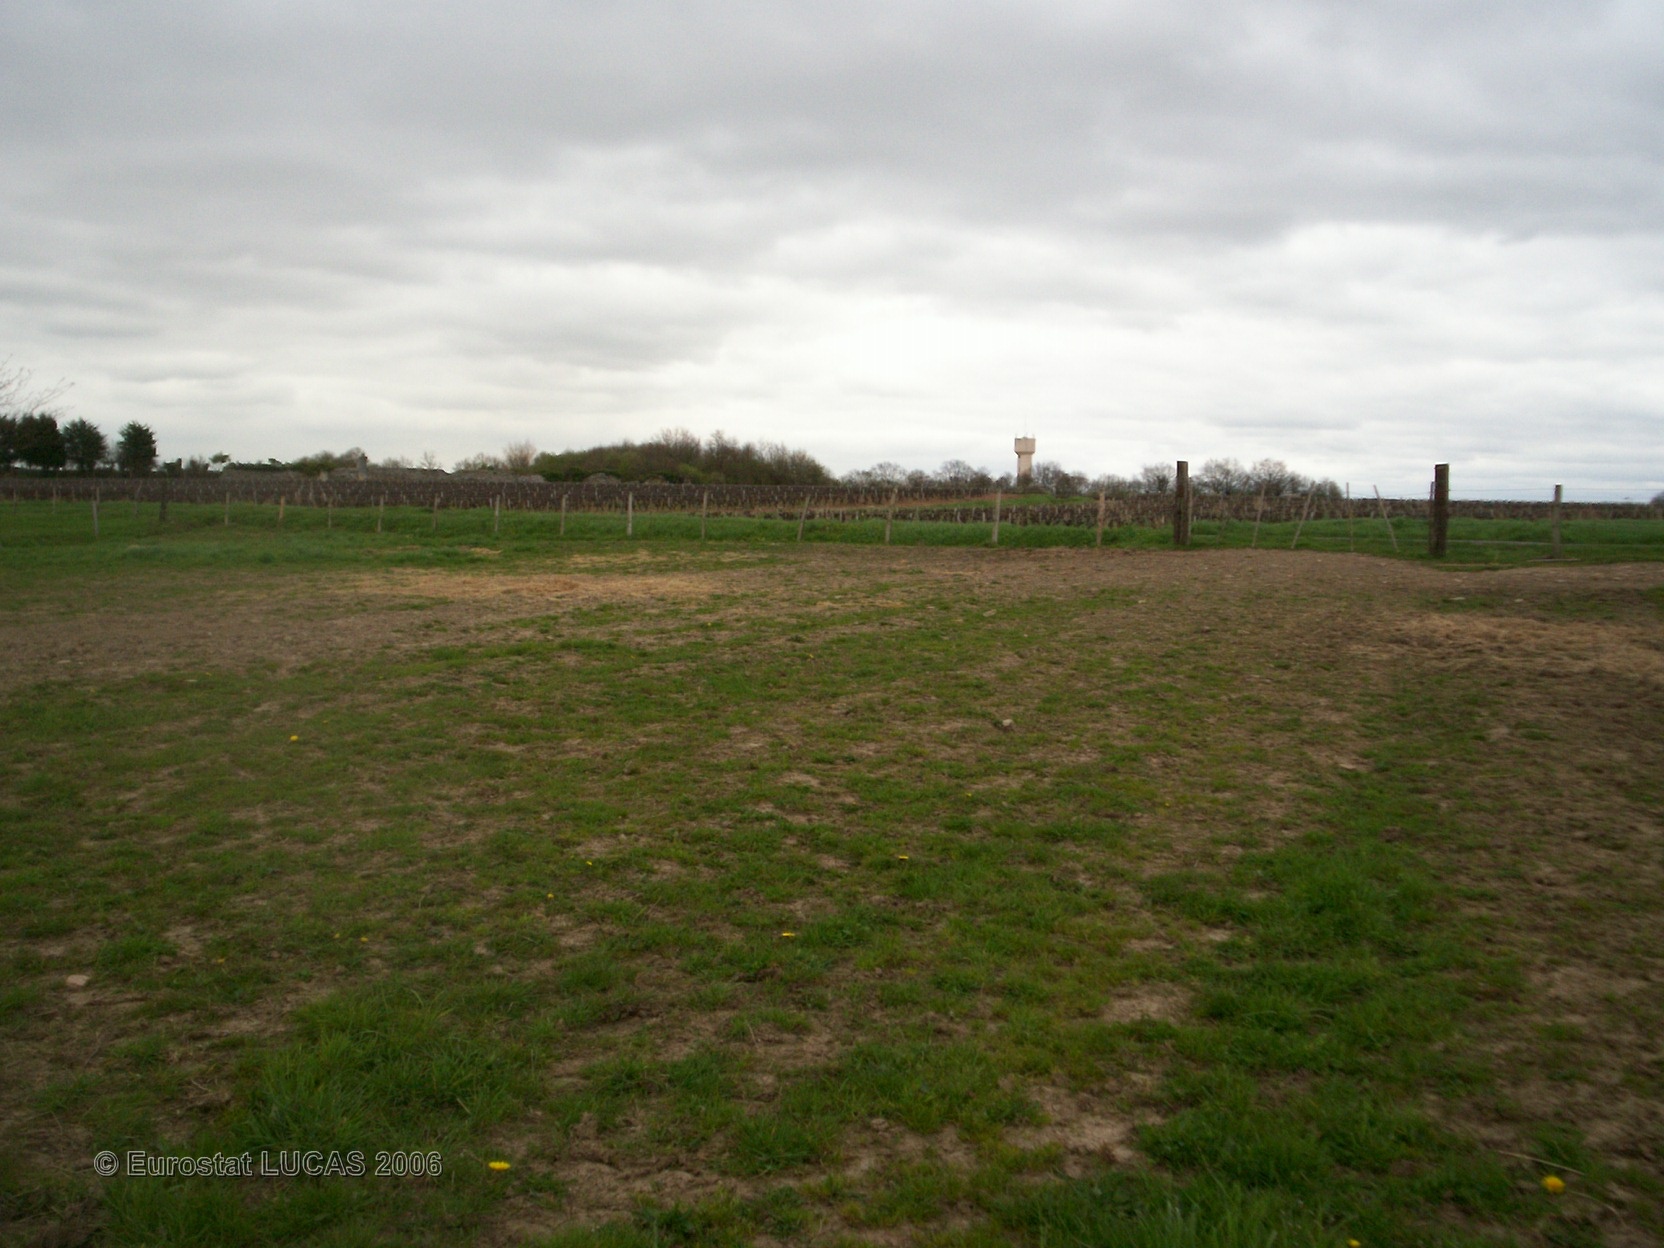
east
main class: Grassland
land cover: Grassland without tree/shrub cover
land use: Agriculture (excluding fallow land and kitchen gardens)
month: April
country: FR
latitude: 47.2550
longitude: -1.3376
